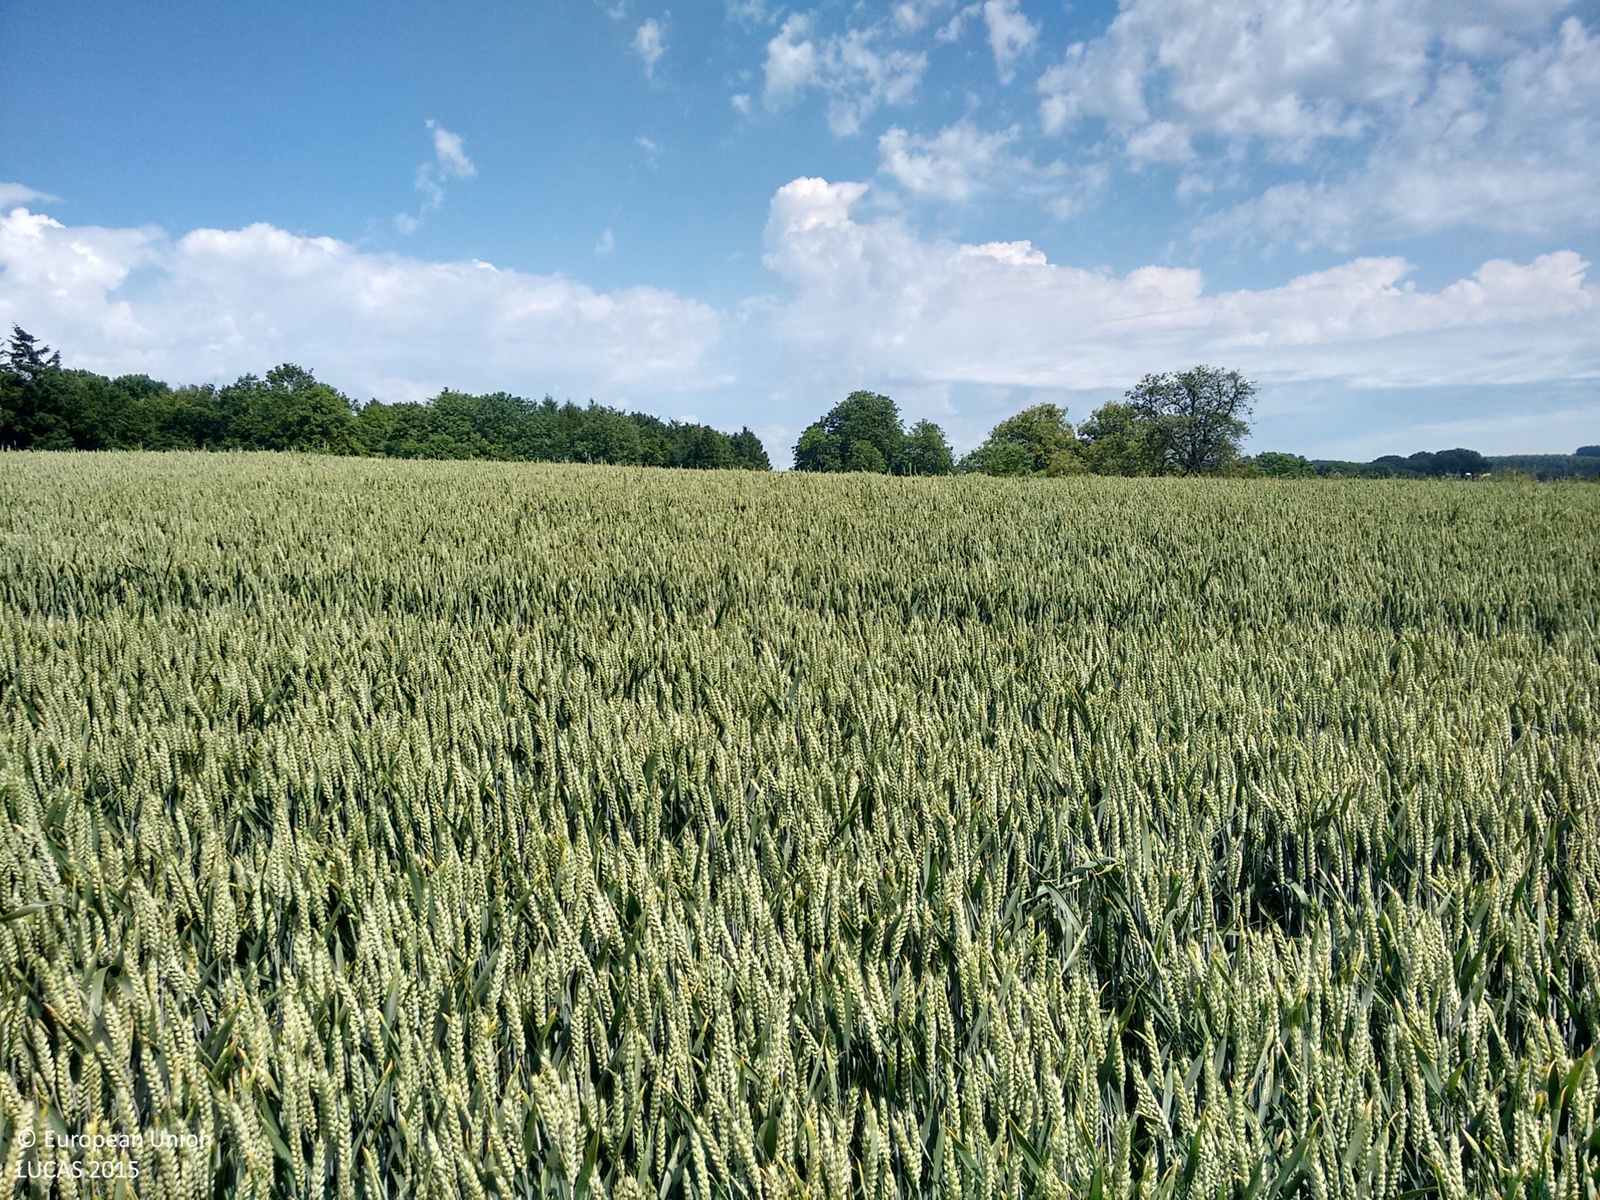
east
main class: Cropland
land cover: Common wheat
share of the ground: > 75 %
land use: Agriculture (excluding fallow land and kitchen gardens)
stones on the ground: < 10 %
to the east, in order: Common wheat; Grassland without tree/shrub cover; Paved roads, cycling and walking lanes; Grass margins; Electric lines; Grassland with sparse tree/shrub cover
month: July
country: GB
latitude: 53.9381
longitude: -0.7484
